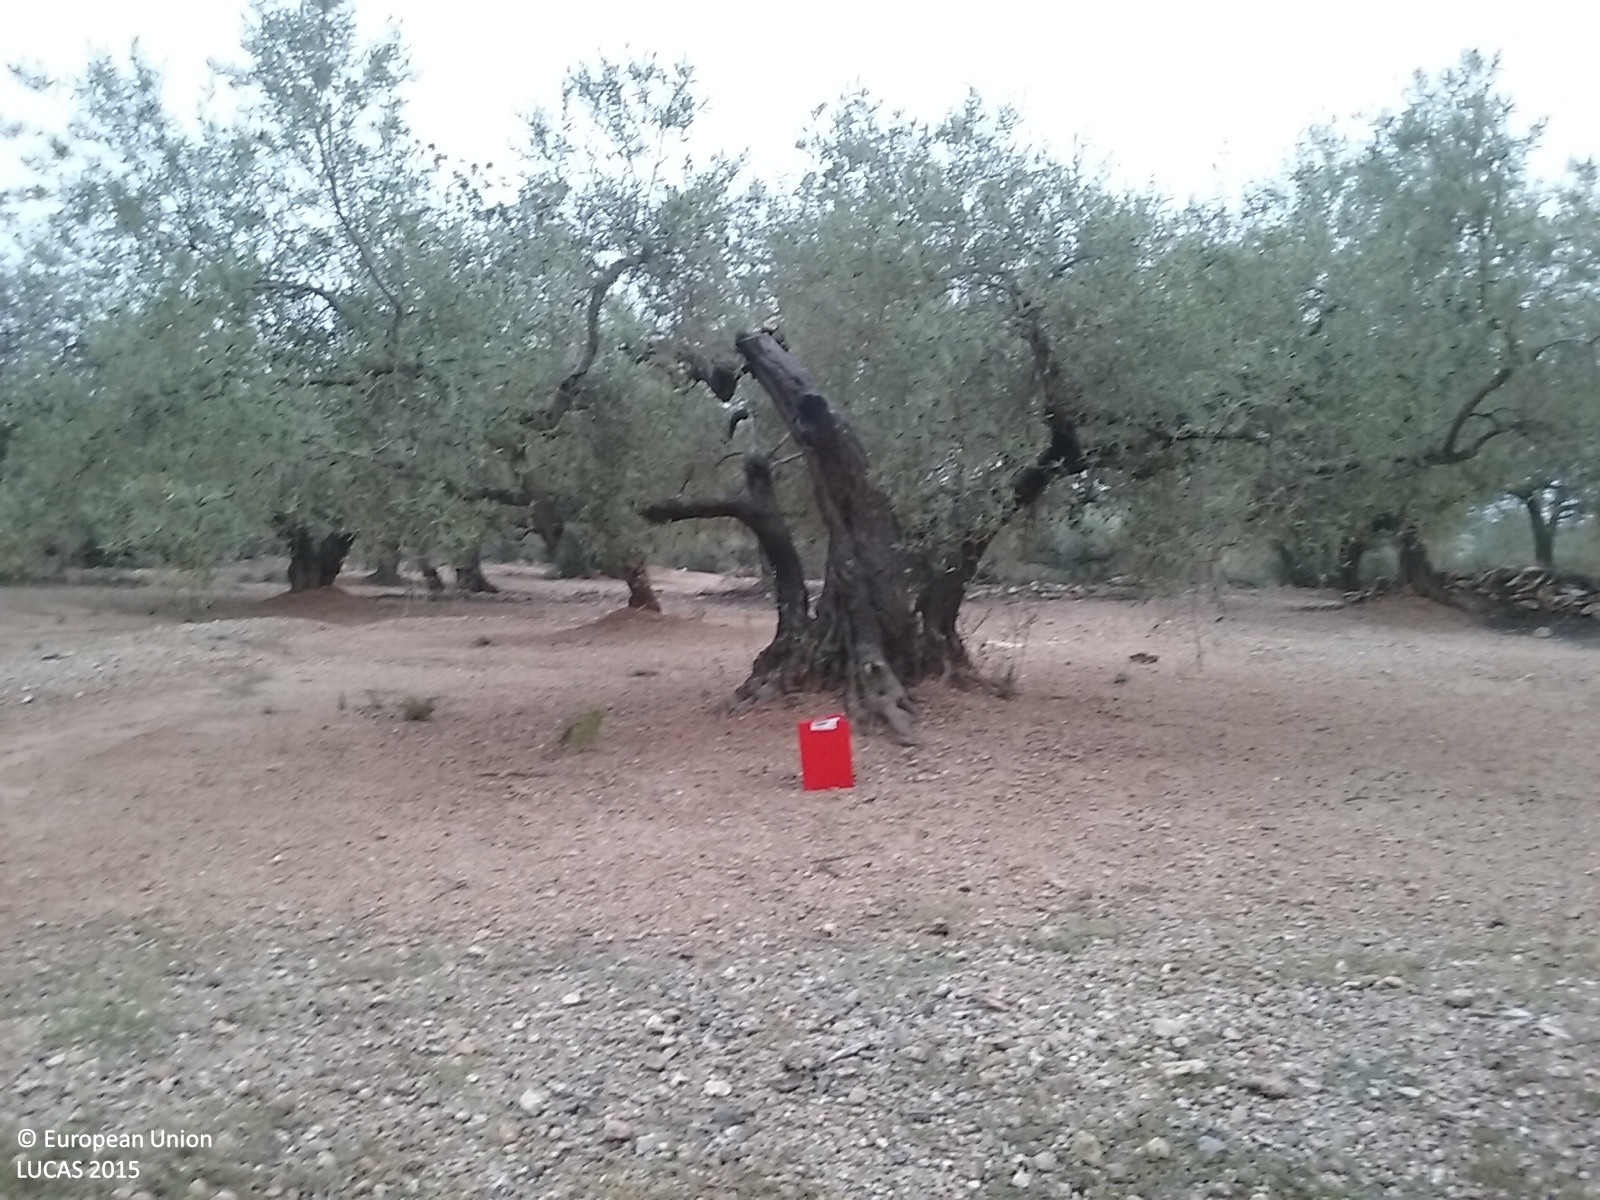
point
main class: Cropland
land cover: Olive groves
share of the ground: 25 - 50 %
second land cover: Other bare soil
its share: > 75 %
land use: Agriculture (excluding fallow land and kitchen gardens)
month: April
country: ES
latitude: 40.8444
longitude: 0.7074
